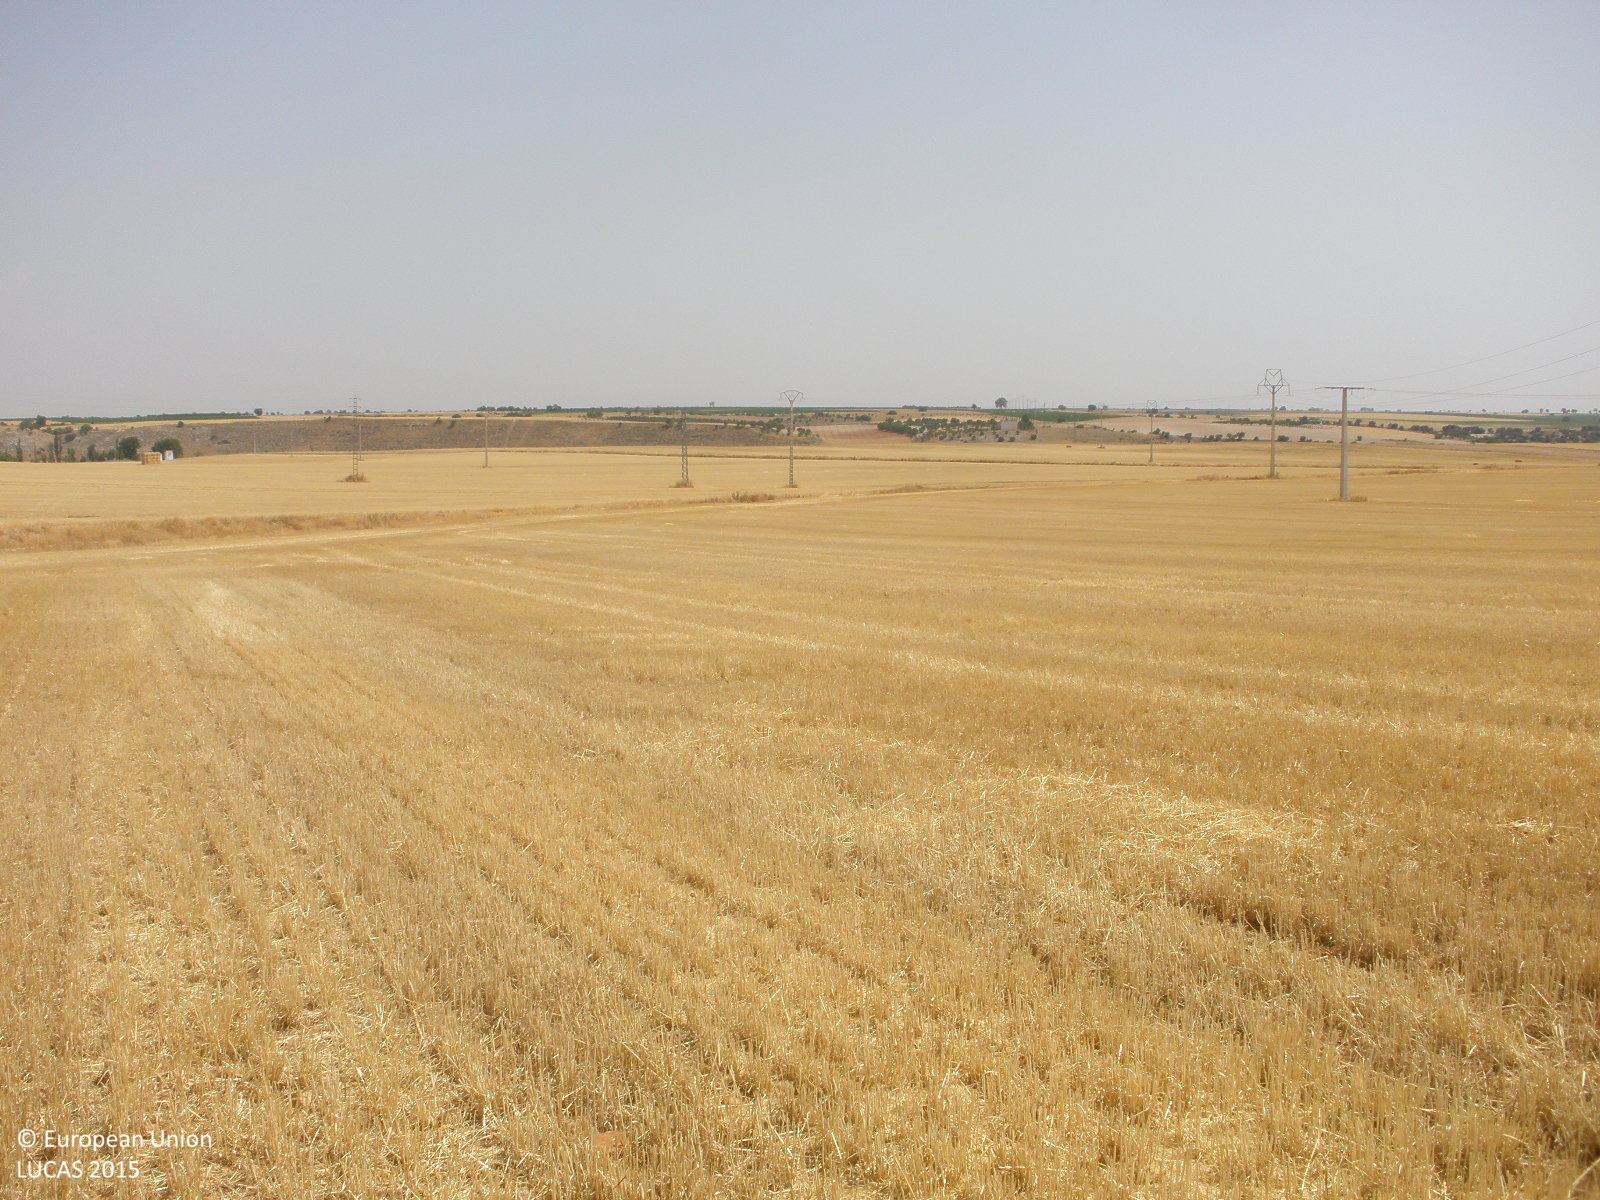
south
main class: Cropland
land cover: Common wheat
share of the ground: < 10 %
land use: Agriculture (excluding fallow land and kitchen gardens)
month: July
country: ES
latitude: 39.7378
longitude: -3.1964
